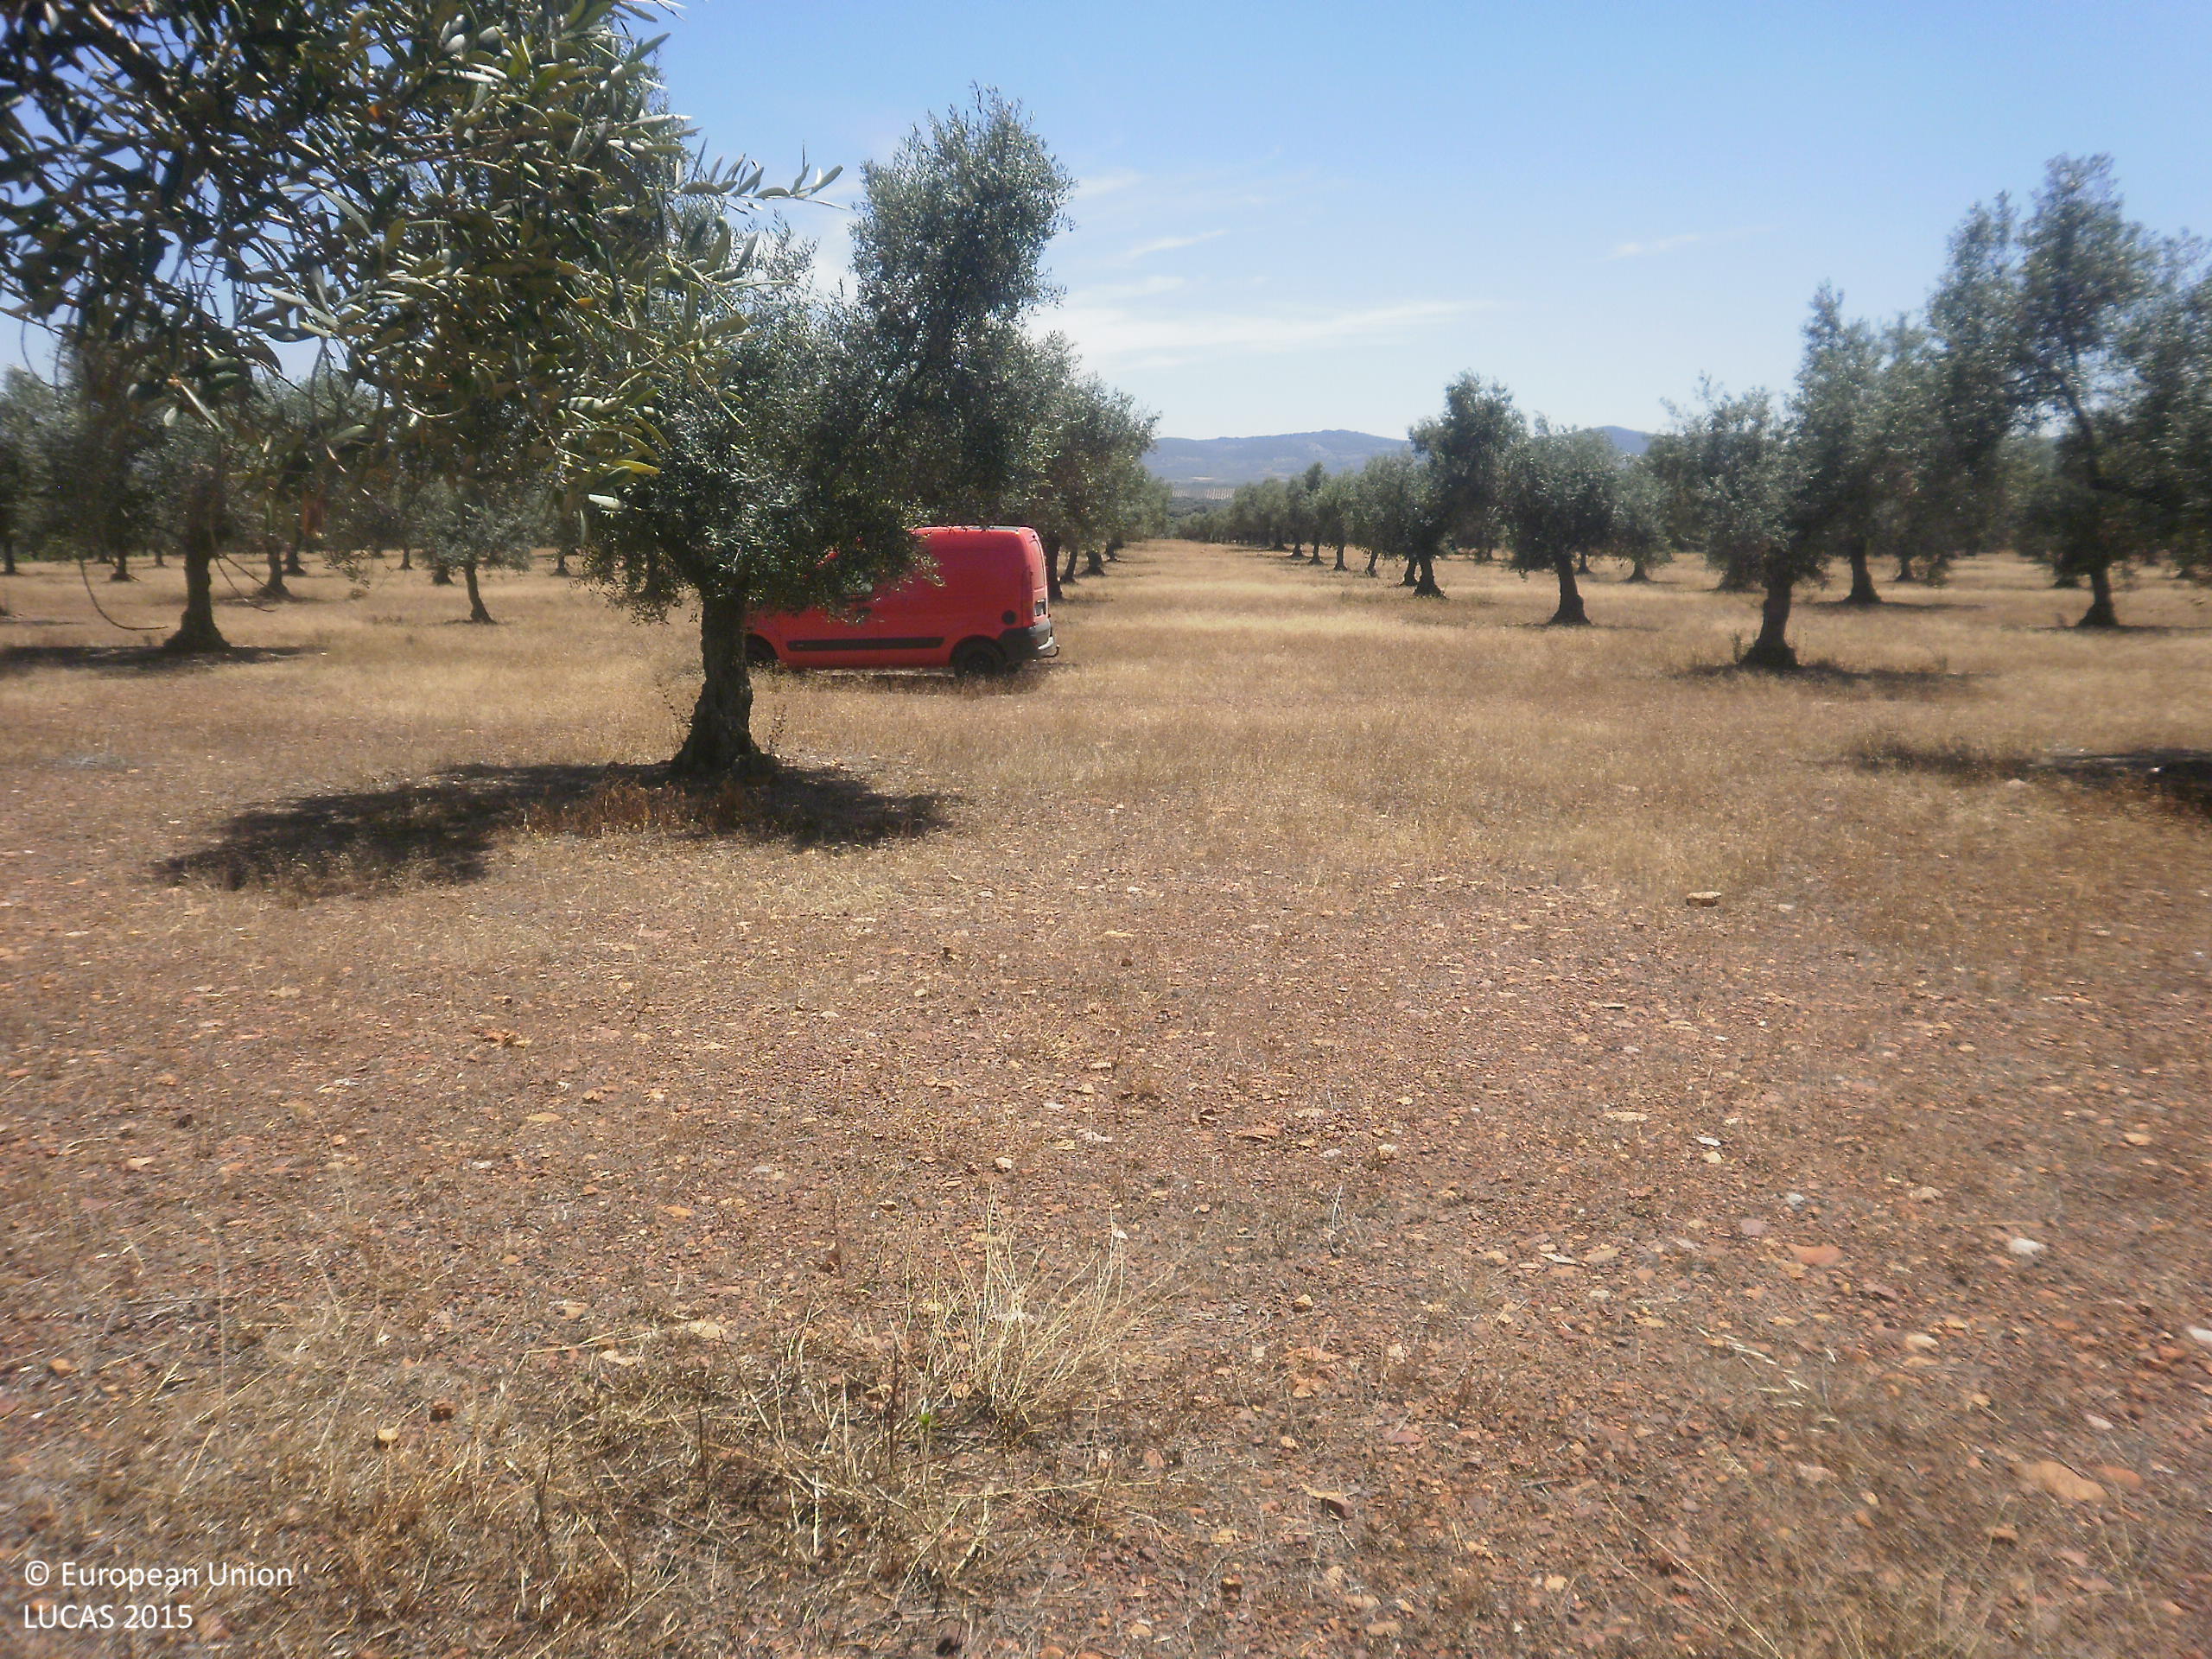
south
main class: Cropland
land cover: Olive groves
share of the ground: 25 - 50 %
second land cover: Grassland without tree/shrub cover
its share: 25 - 50 %
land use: Agriculture (excluding fallow land and kitchen gardens)
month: June
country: ES
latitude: 38.6711
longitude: -5.4271
